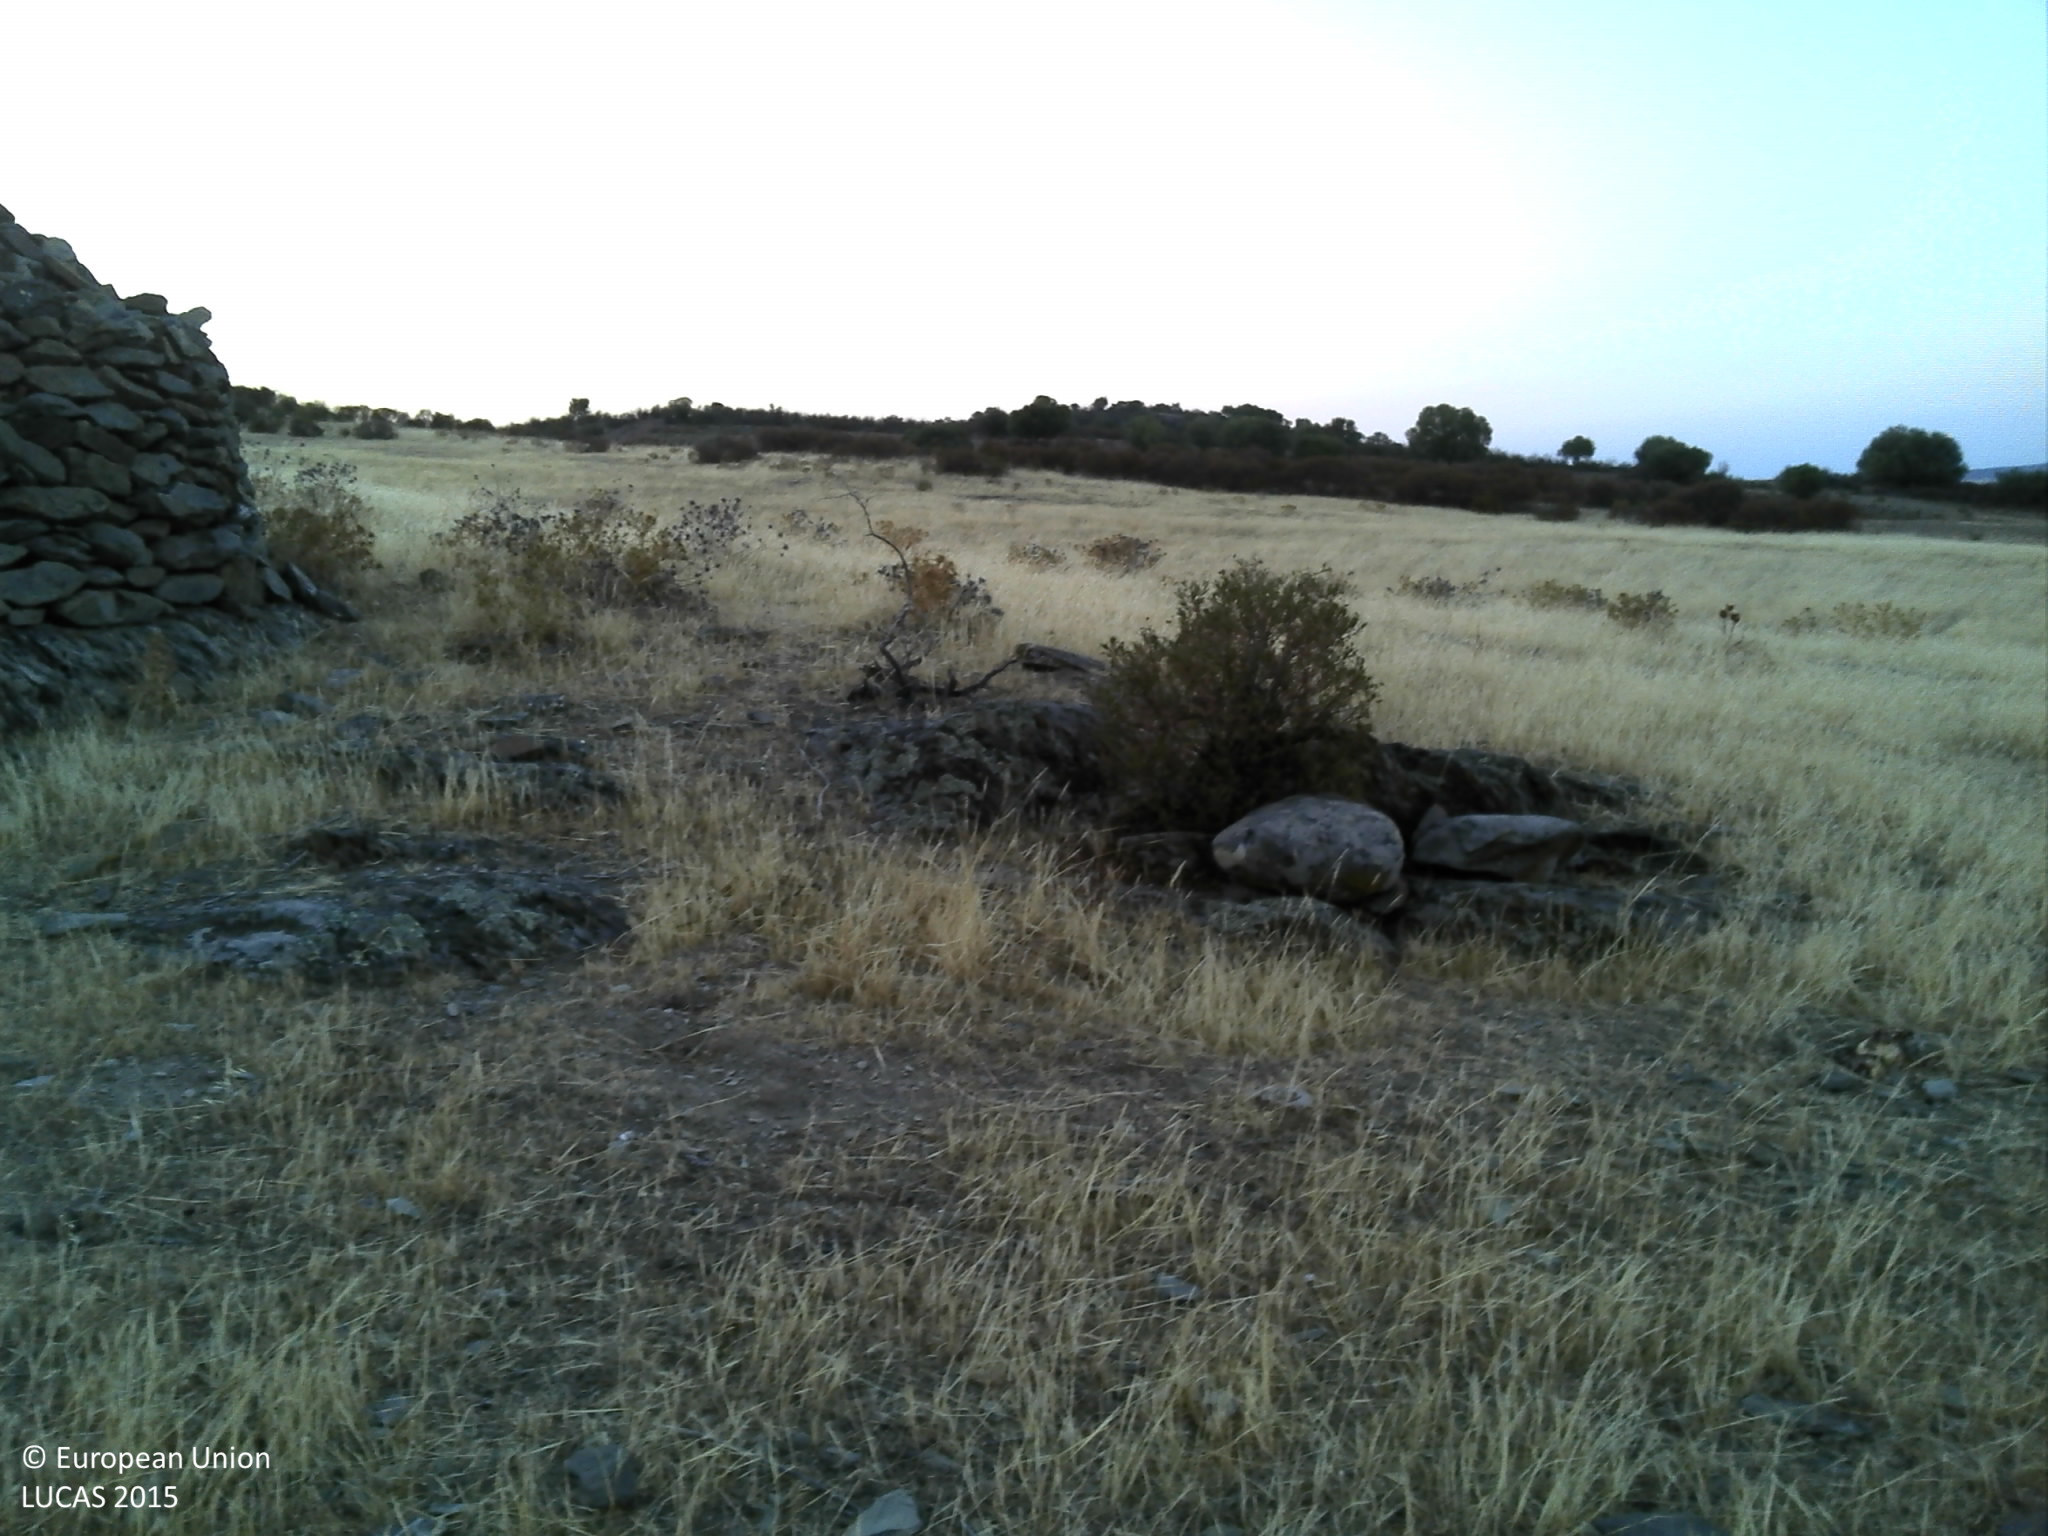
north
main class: Grassland
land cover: Grassland without tree/shrub cover
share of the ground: 50 - 75 %
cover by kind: herbaceous plants 65 %, unconsolidated bare surface 35 %
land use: Agriculture (excluding fallow land and kitchen gardens)
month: July
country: PT
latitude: 37.6012
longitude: -7.8358
